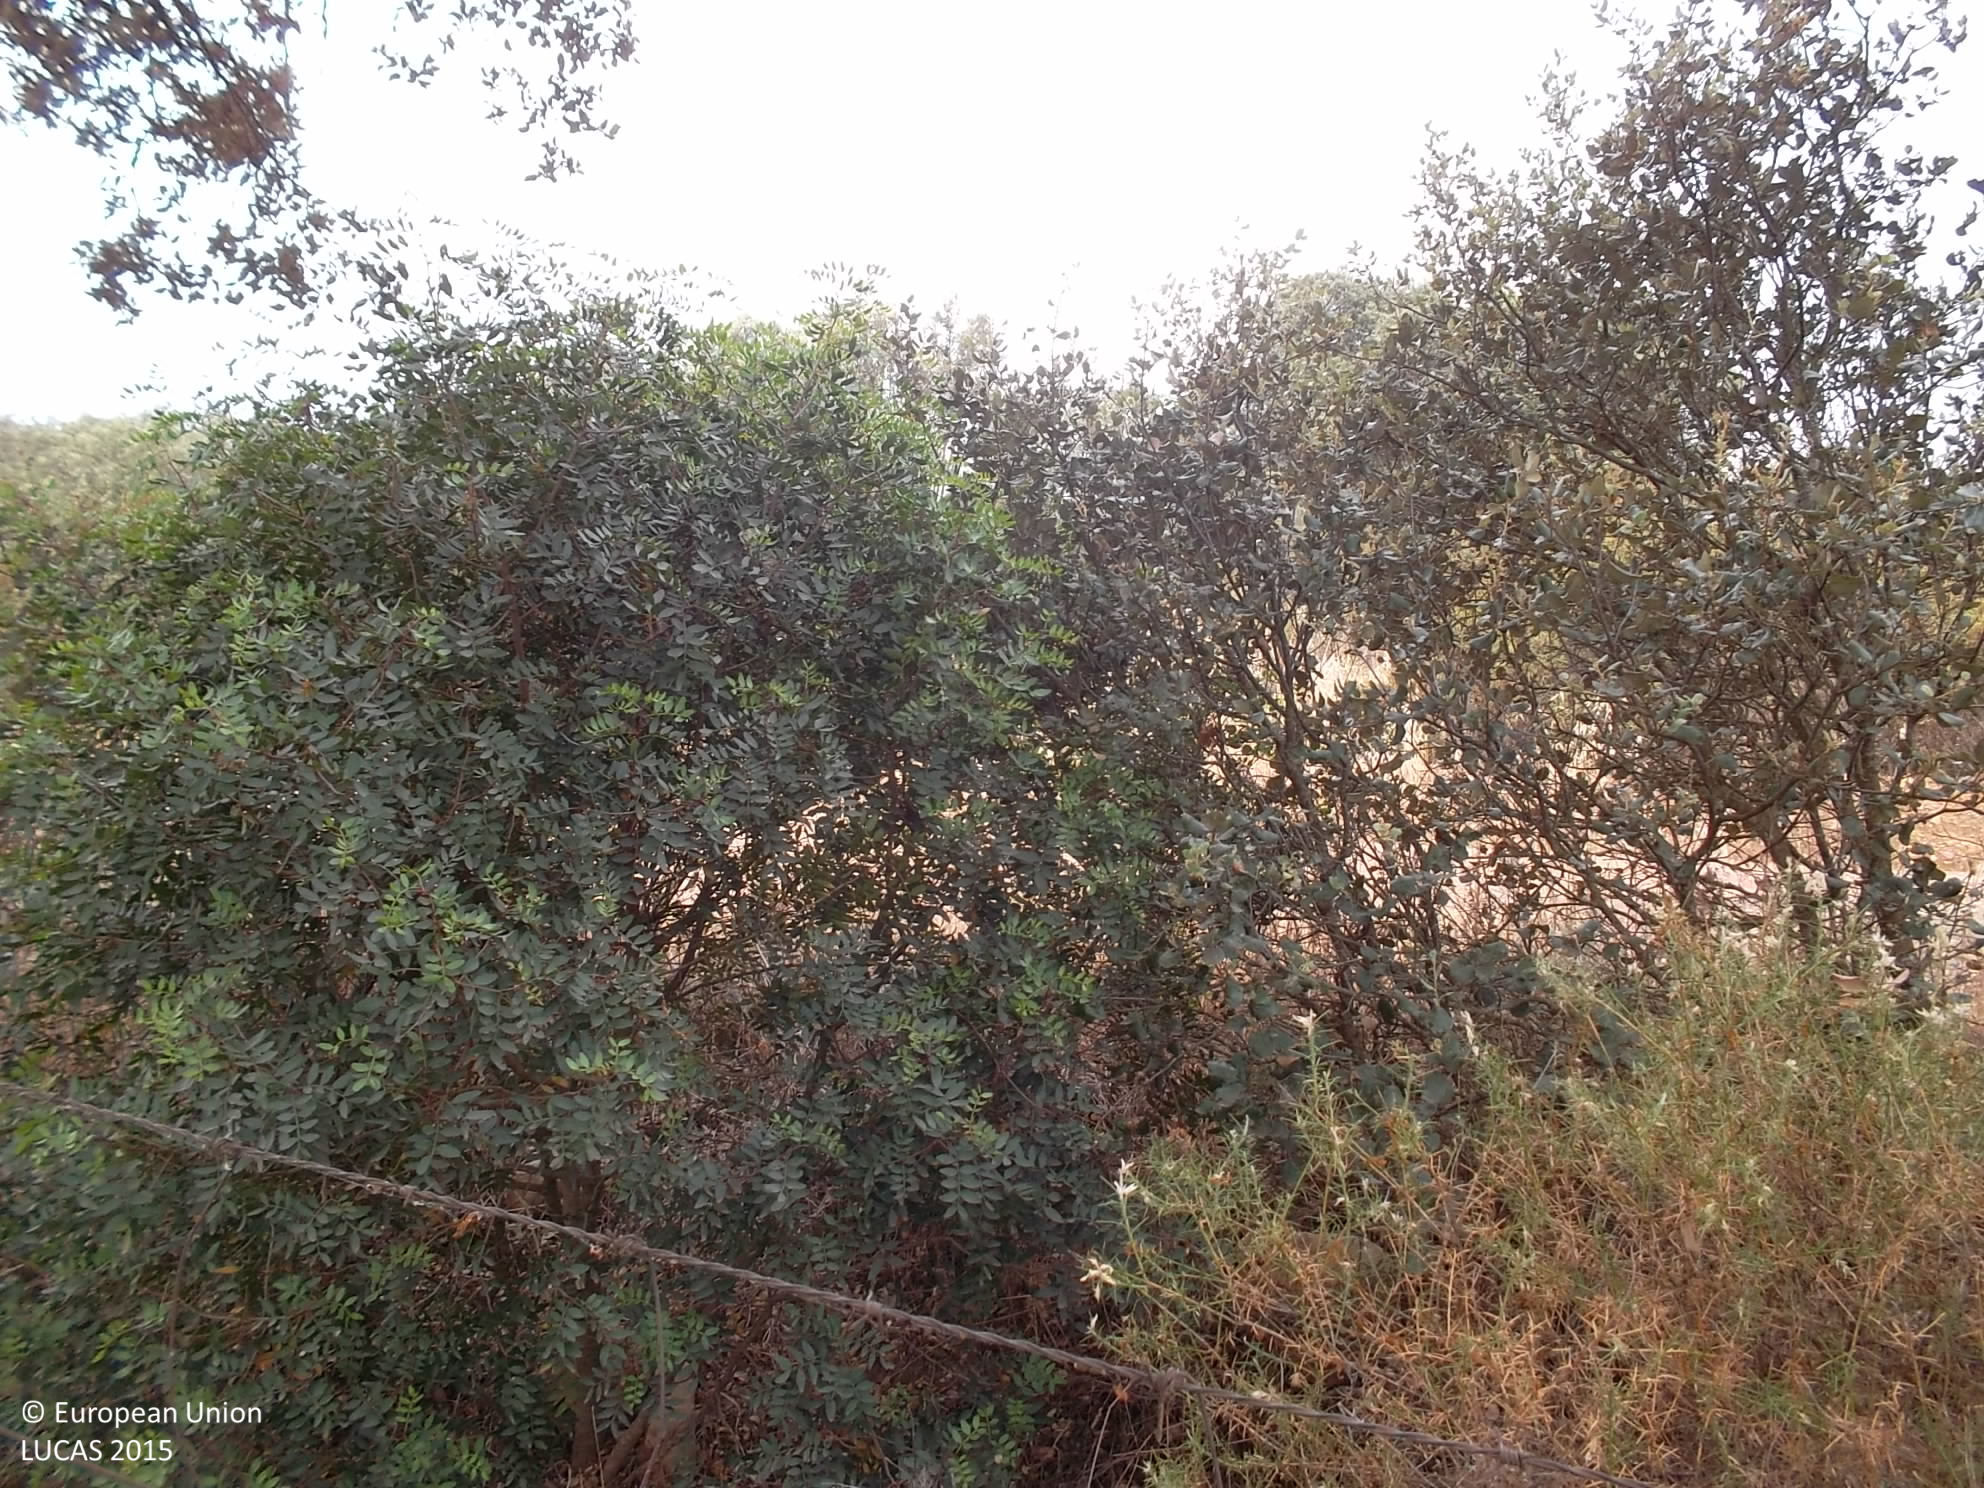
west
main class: Woodland
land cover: Broadleaved woodland
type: broadleaved evergreen forest
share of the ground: 25 - 50 %
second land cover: Grassland without tree/shrub cover
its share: > 75 %
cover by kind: broadleaved forest trees 30 %, herbaceous plants 30 %, shrubs 20 %, unconsolidated bare surface 20 %
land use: Forestry
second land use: Agriculture (excluding fallow land and kitchen gardens)
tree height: > 5 m
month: June
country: ES
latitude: 39.0219
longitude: -4.4777
